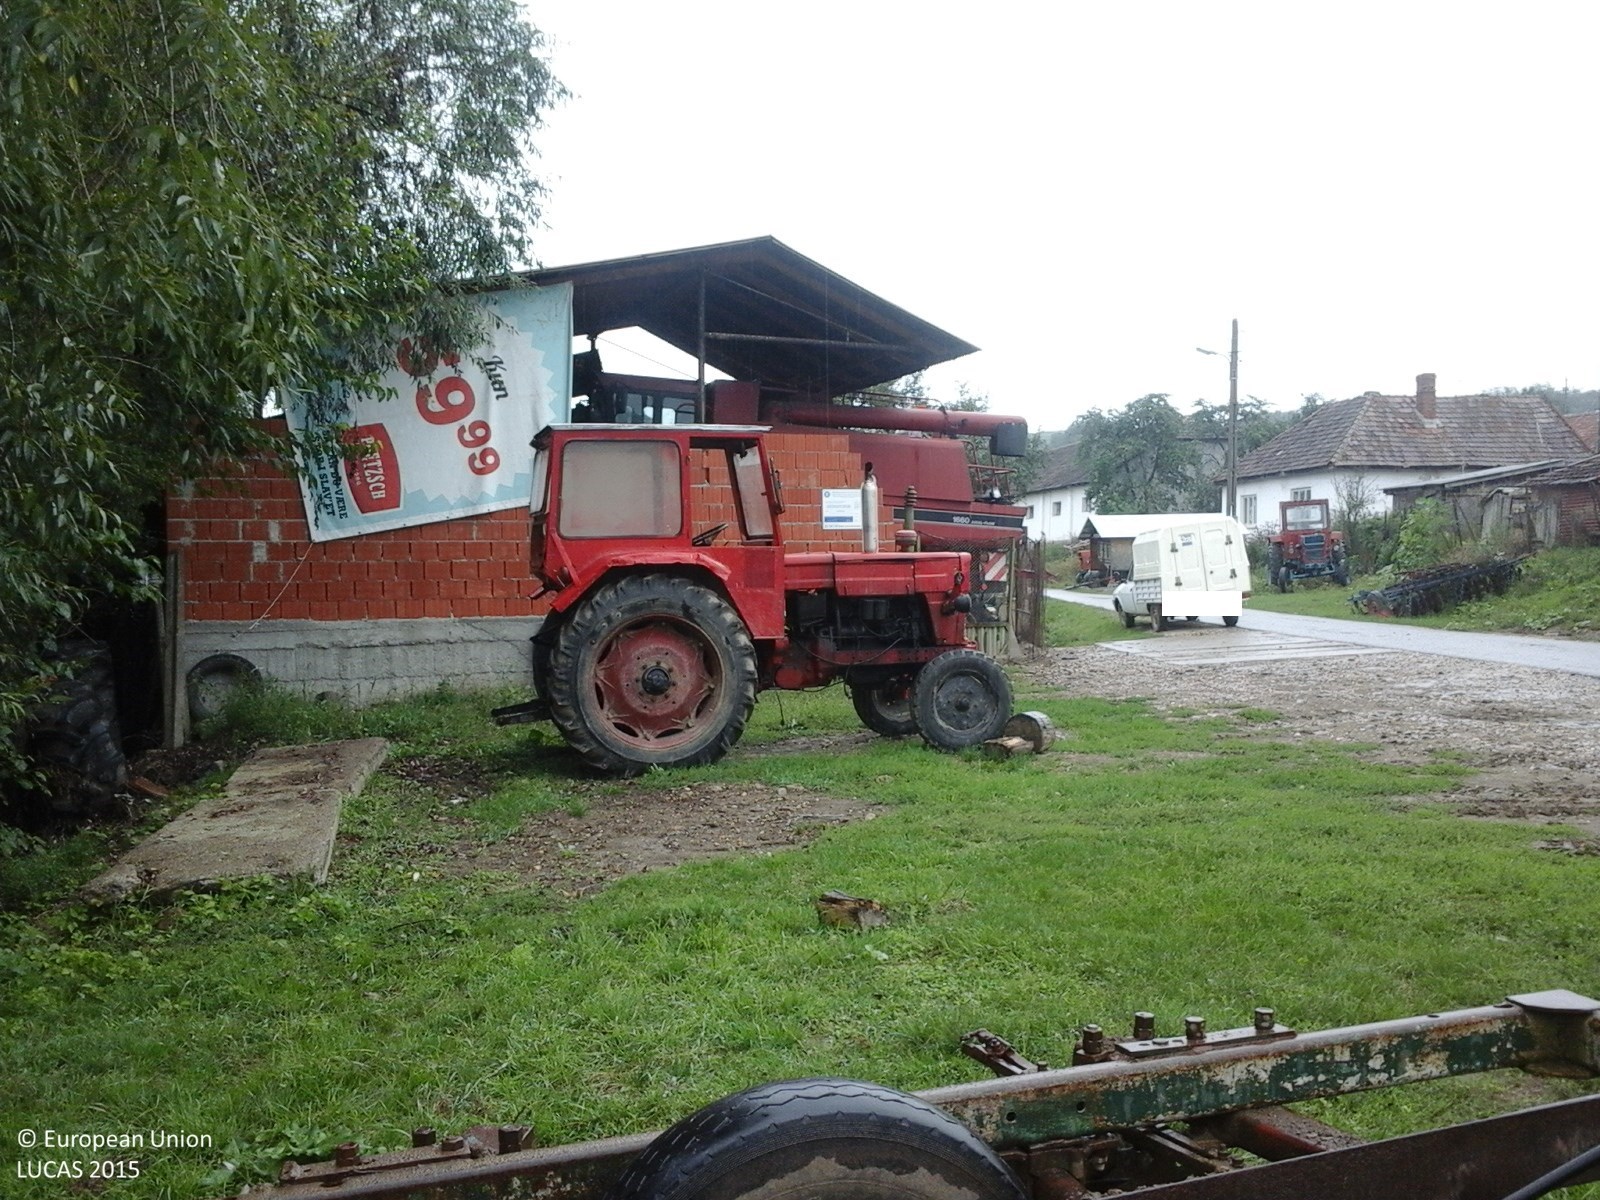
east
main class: Grassland
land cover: Grassland without tree/shrub cover
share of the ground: > 75 %
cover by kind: herbaceous plants 100 %
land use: Residential
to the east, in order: Grassland without tree/shrub cover; Artificial constructions in urban areas; Maize; Artificial constructions in urban areas
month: September
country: RO
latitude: 47.3172
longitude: 22.4244
